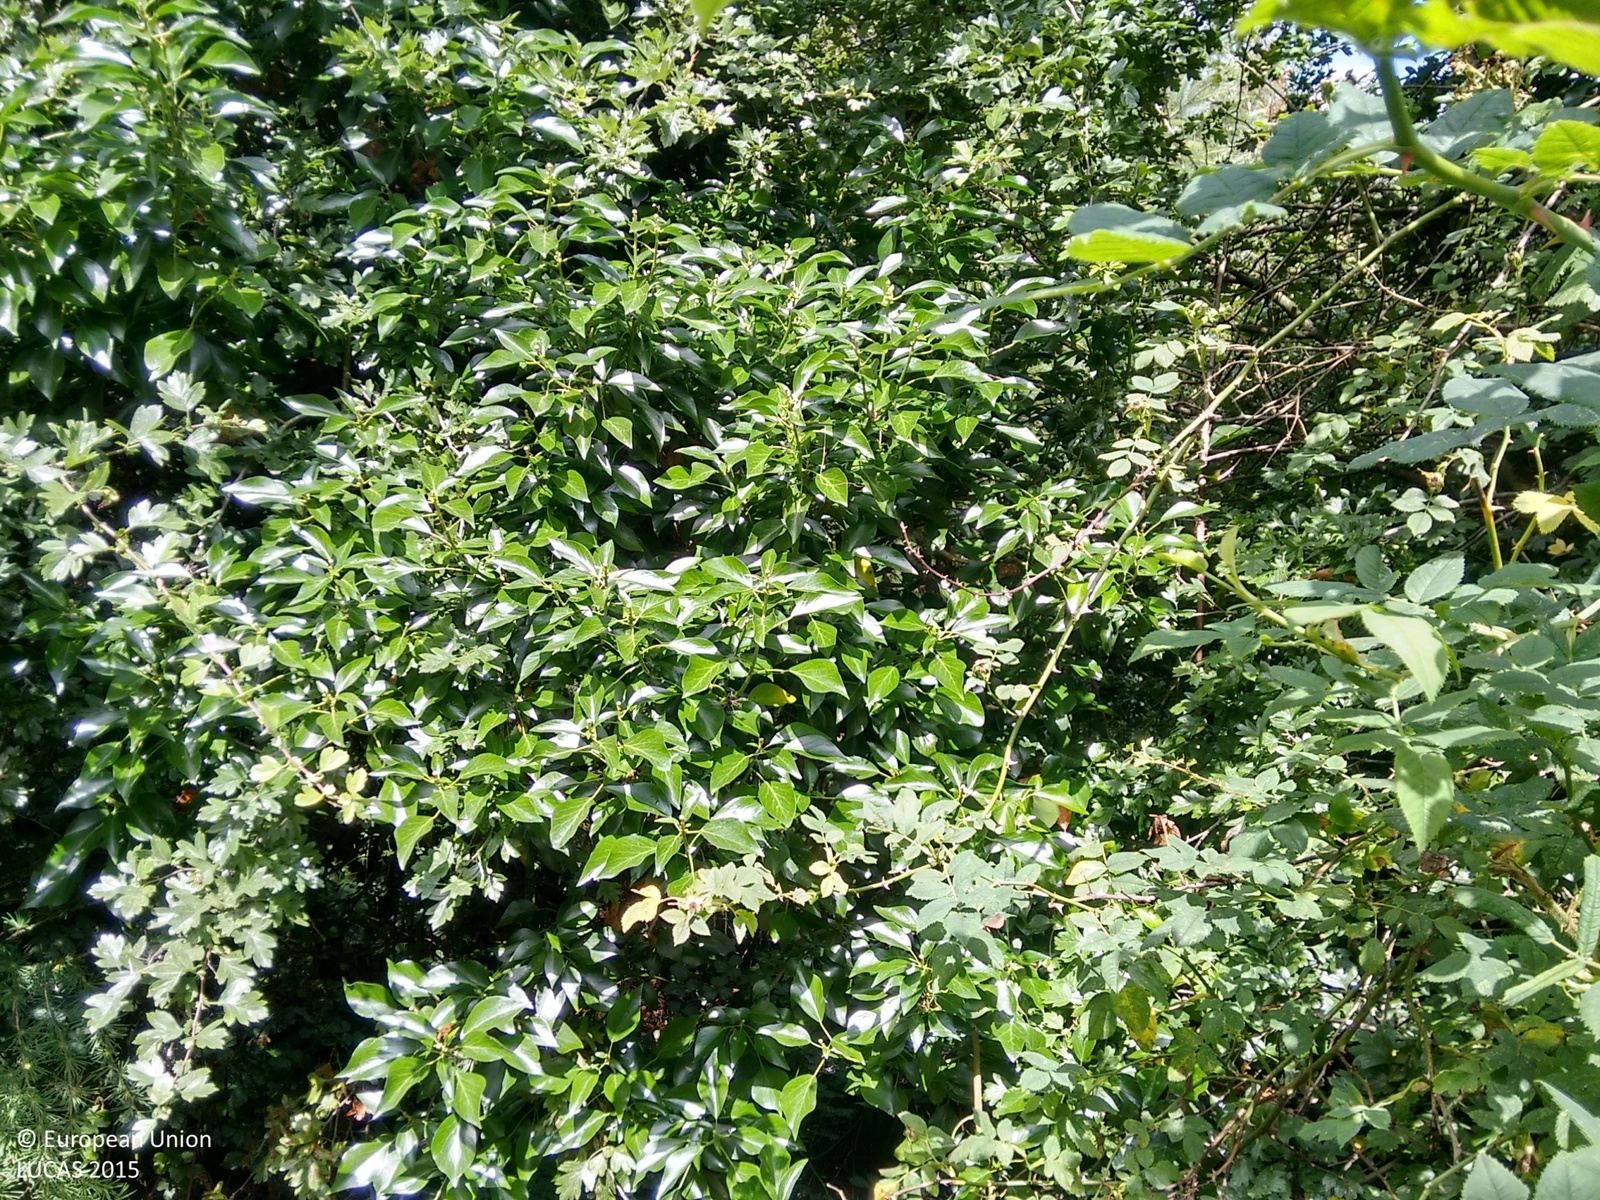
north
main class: Woodland
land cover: Spruce dominated mixed woodland
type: exotic forest
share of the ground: > 75 %
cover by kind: coniferous forest trees 75 %, broadleaved forest trees 25 %
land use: Forestry
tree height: > 5 m
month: August
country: IE
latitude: 52.6432
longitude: -6.2441
